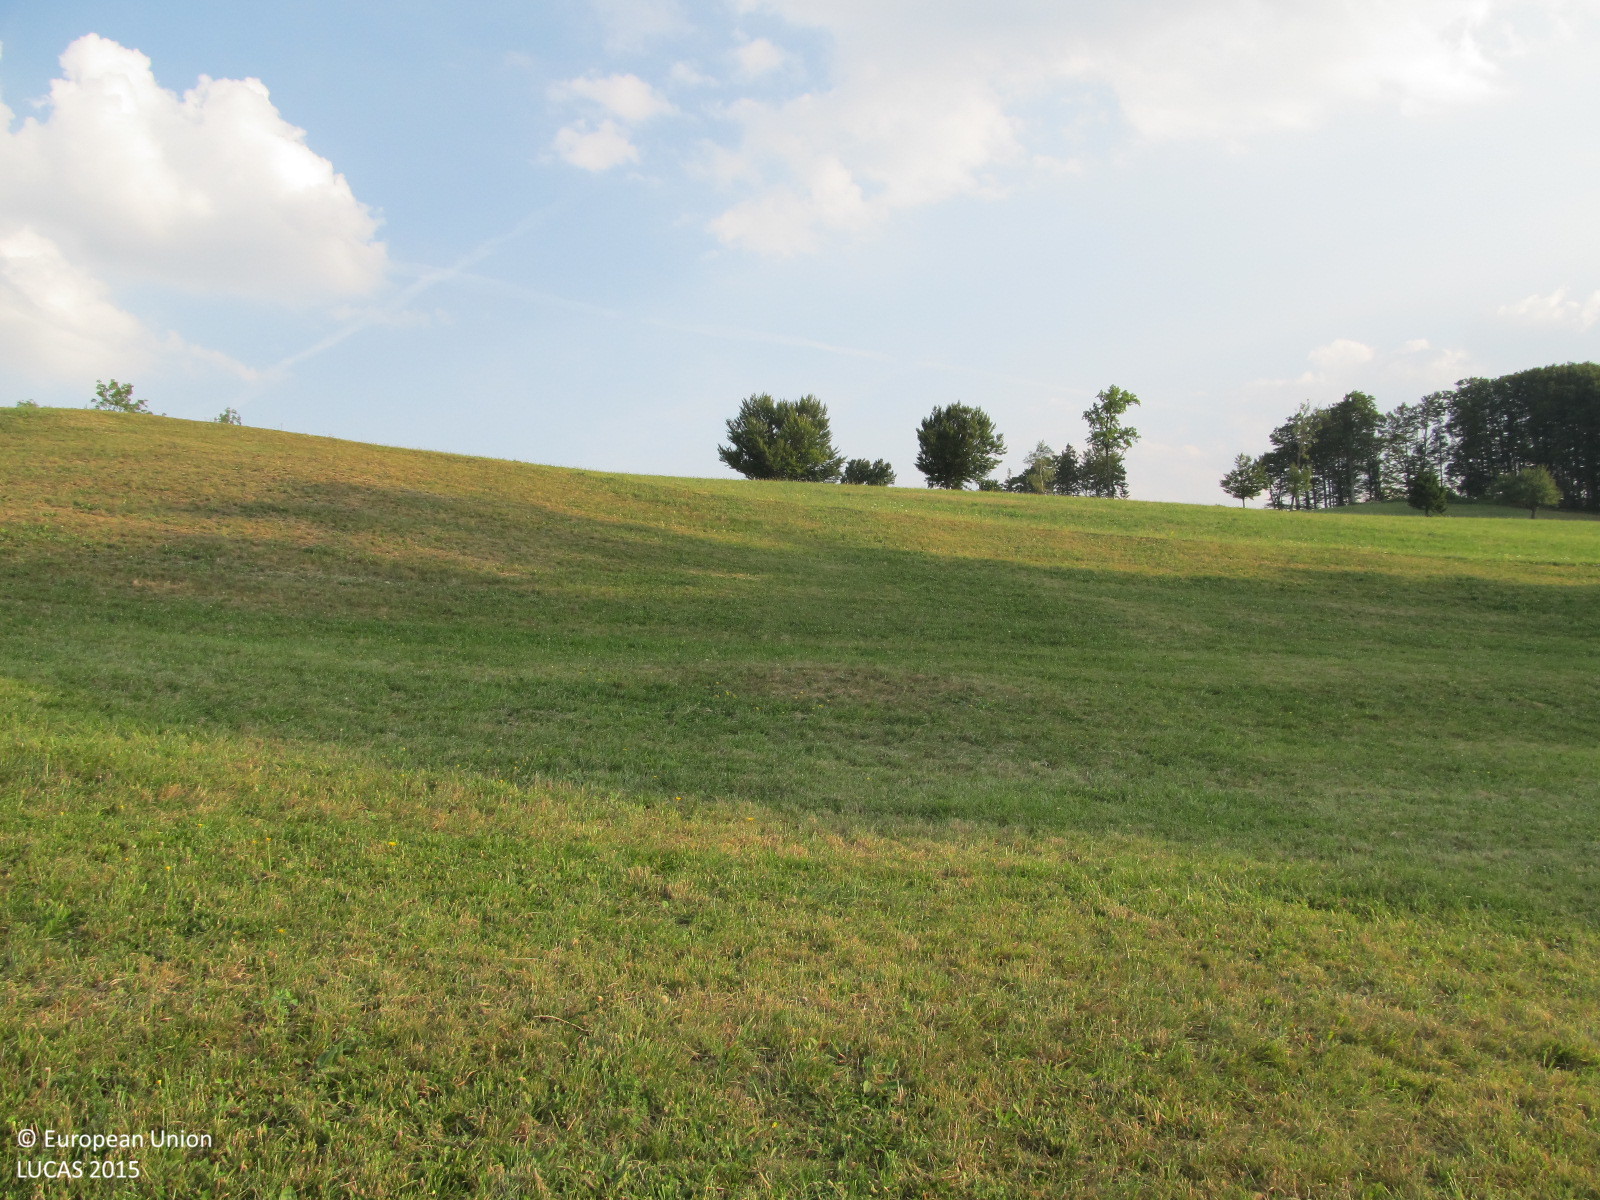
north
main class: Grassland
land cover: Grassland without tree/shrub cover
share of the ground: > 75 %
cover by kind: herbaceous plants 100 %
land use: Agriculture (excluding fallow land and kitchen gardens)
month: August
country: AT
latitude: 48.0381
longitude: 15.3801
